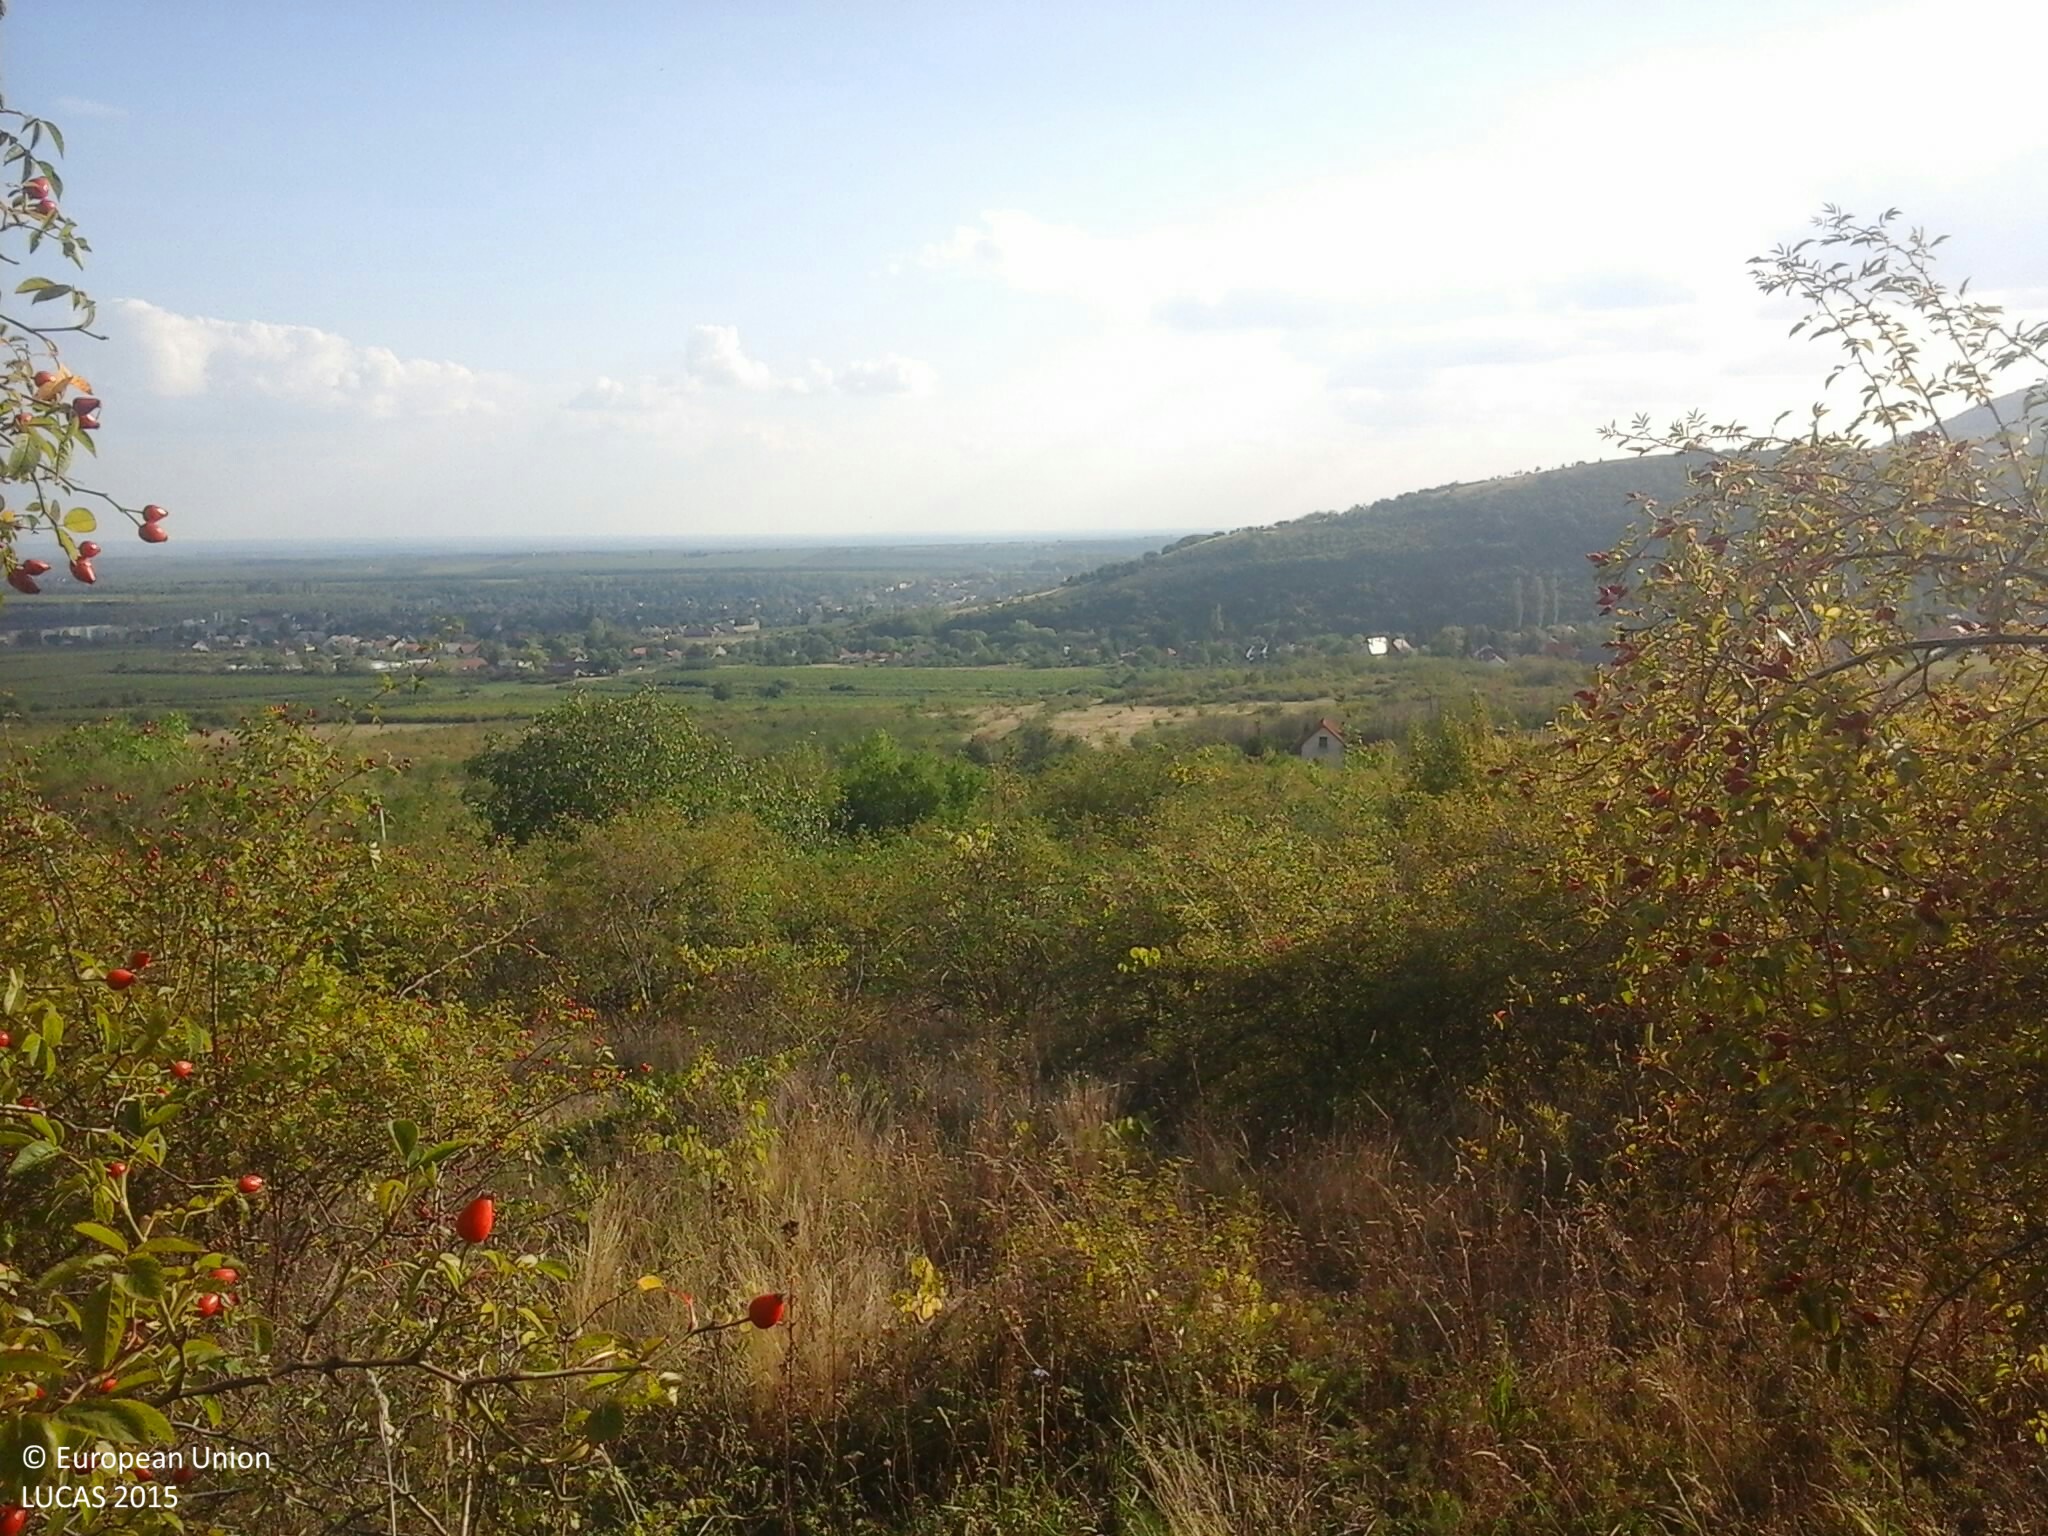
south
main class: Shrubland
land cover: Shrubland without tree cover
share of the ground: > 75 %
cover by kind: shrubs 75 %, herbaceous plants 25 %
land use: Semi-natural and natural areas not in use
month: September
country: HU
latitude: 47.8217
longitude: 20.0048
